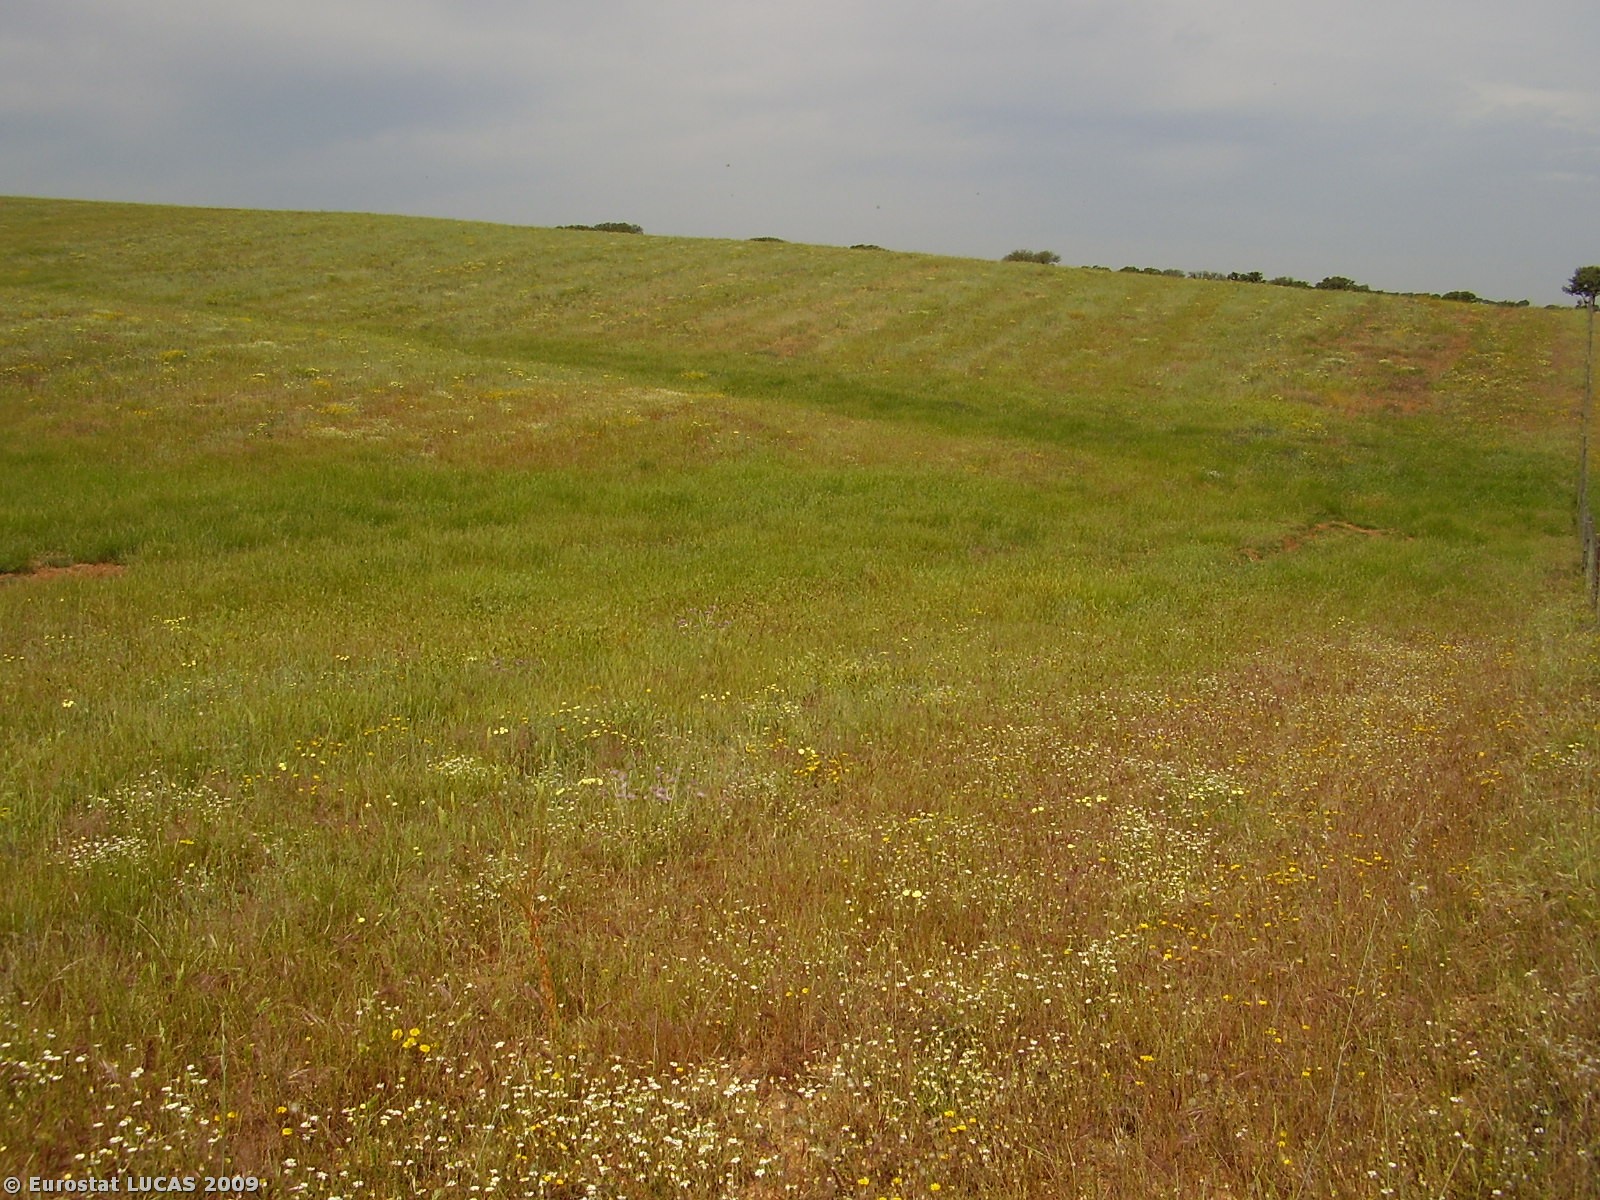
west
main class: Grassland
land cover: Grassland with sparse tree/shrub cover
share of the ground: > 75 %
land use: Agriculture (excluding fallow land and kitchen gardens)
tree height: > 5 m
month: May
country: PT
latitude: 37.9179
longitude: -7.9204
